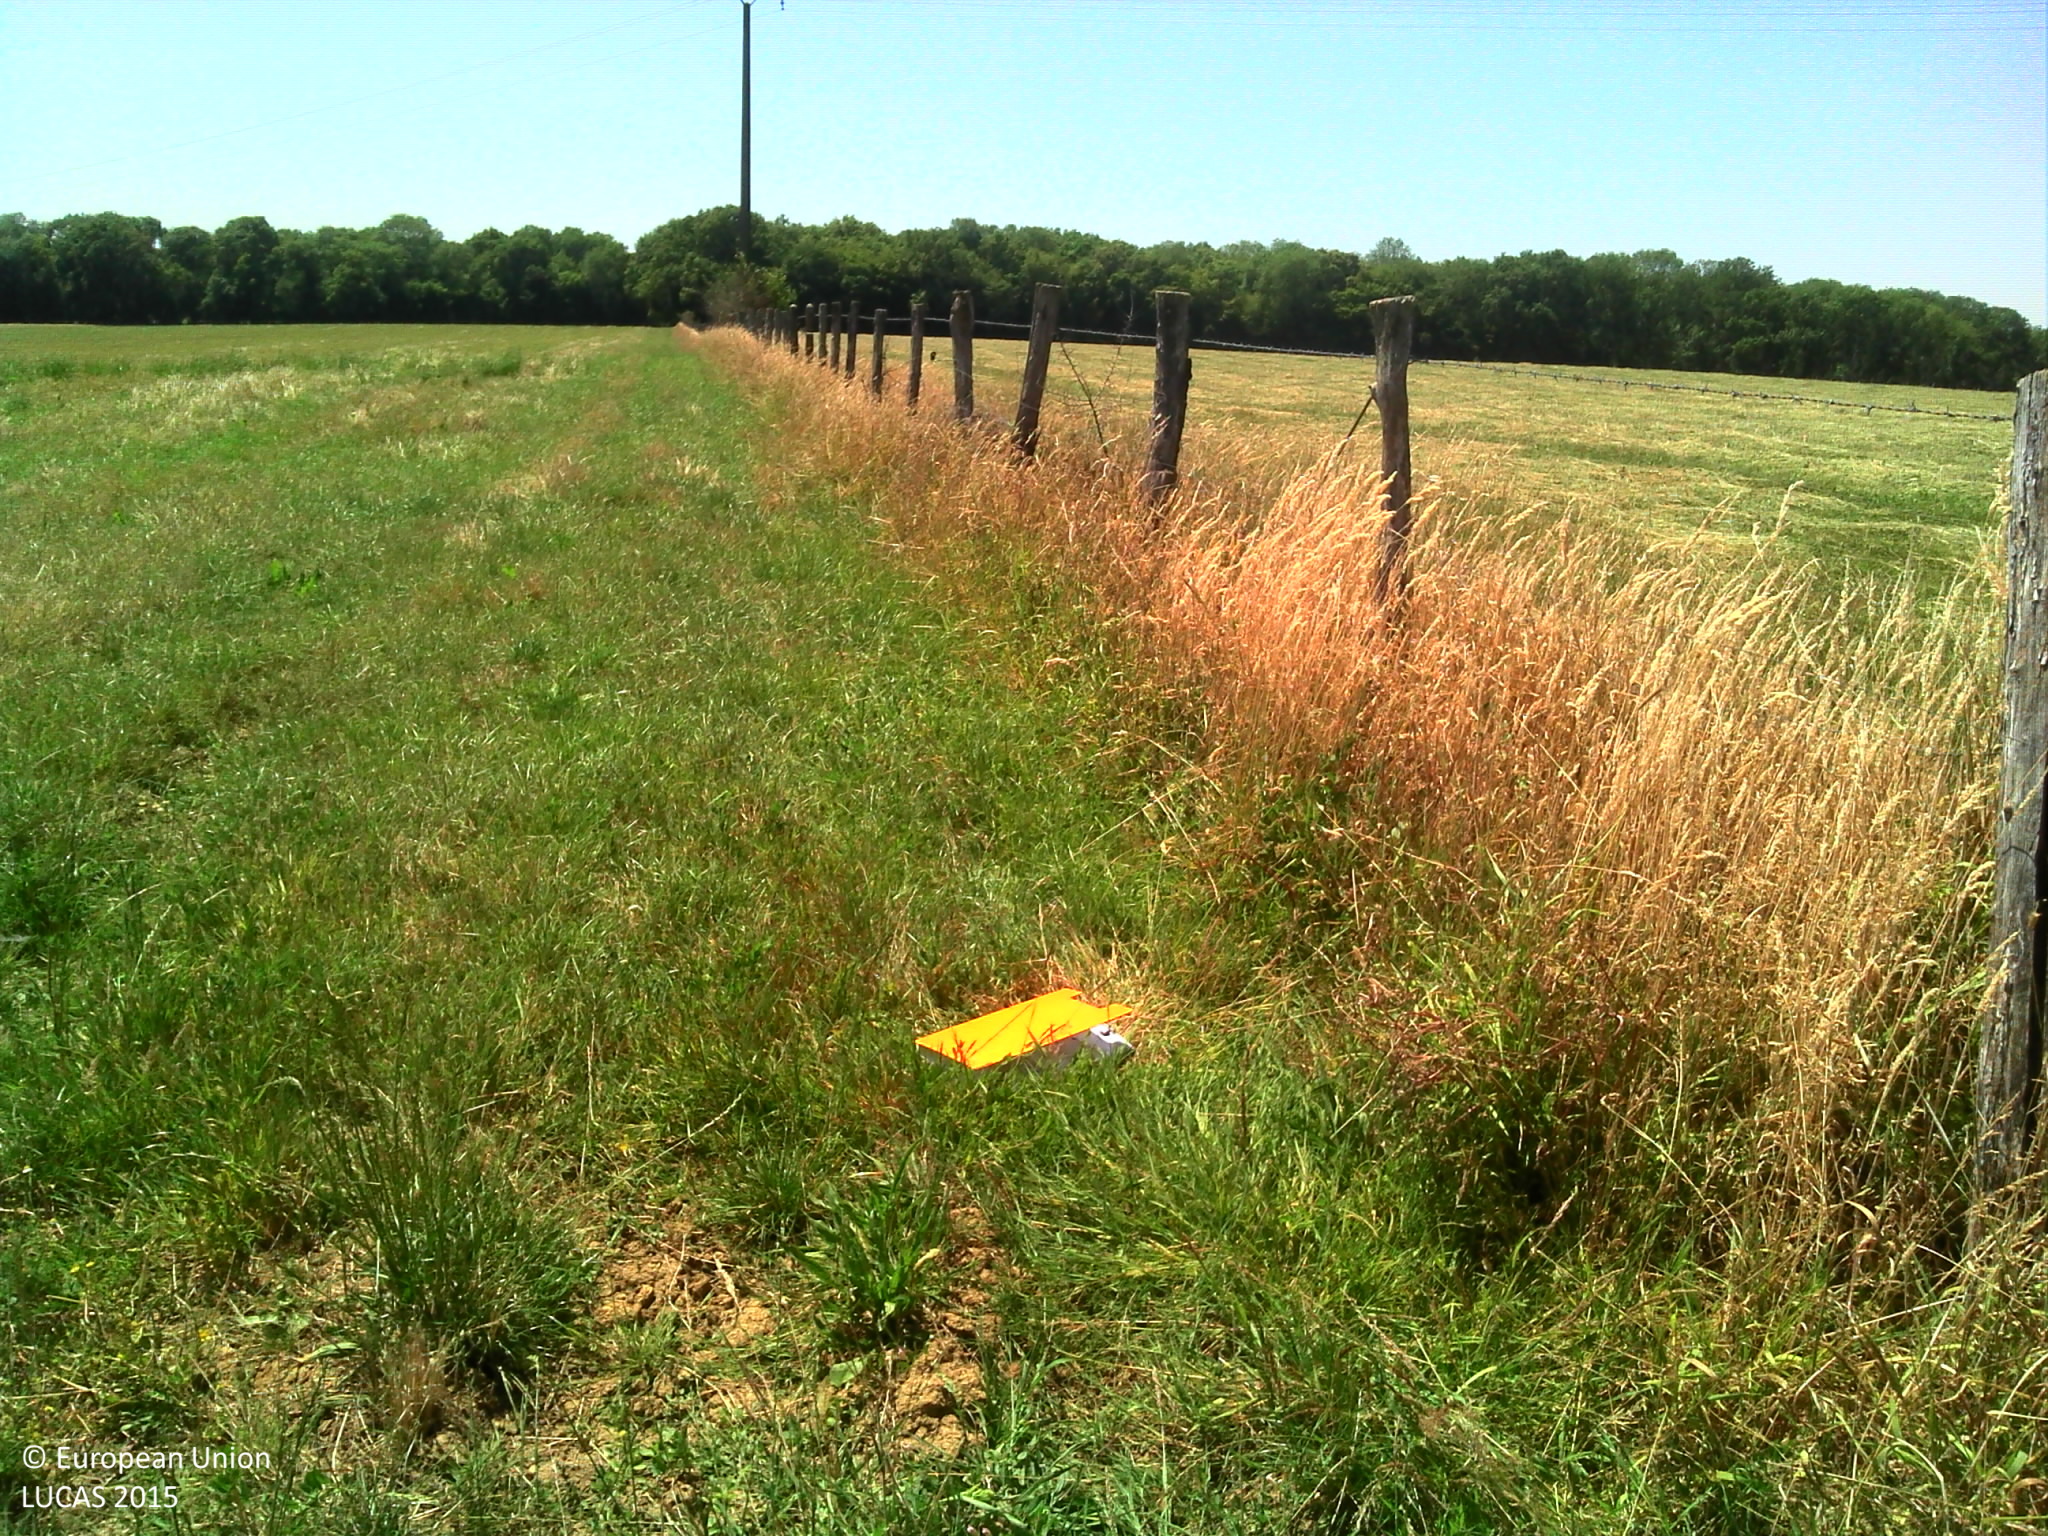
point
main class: Grassland
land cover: Grassland without tree/shrub cover
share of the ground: > 75 %
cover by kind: herbaceous plants 100 %
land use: Agriculture (excluding fallow land and kitchen gardens)
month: June
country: FR
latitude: 46.9363
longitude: 3.6010
